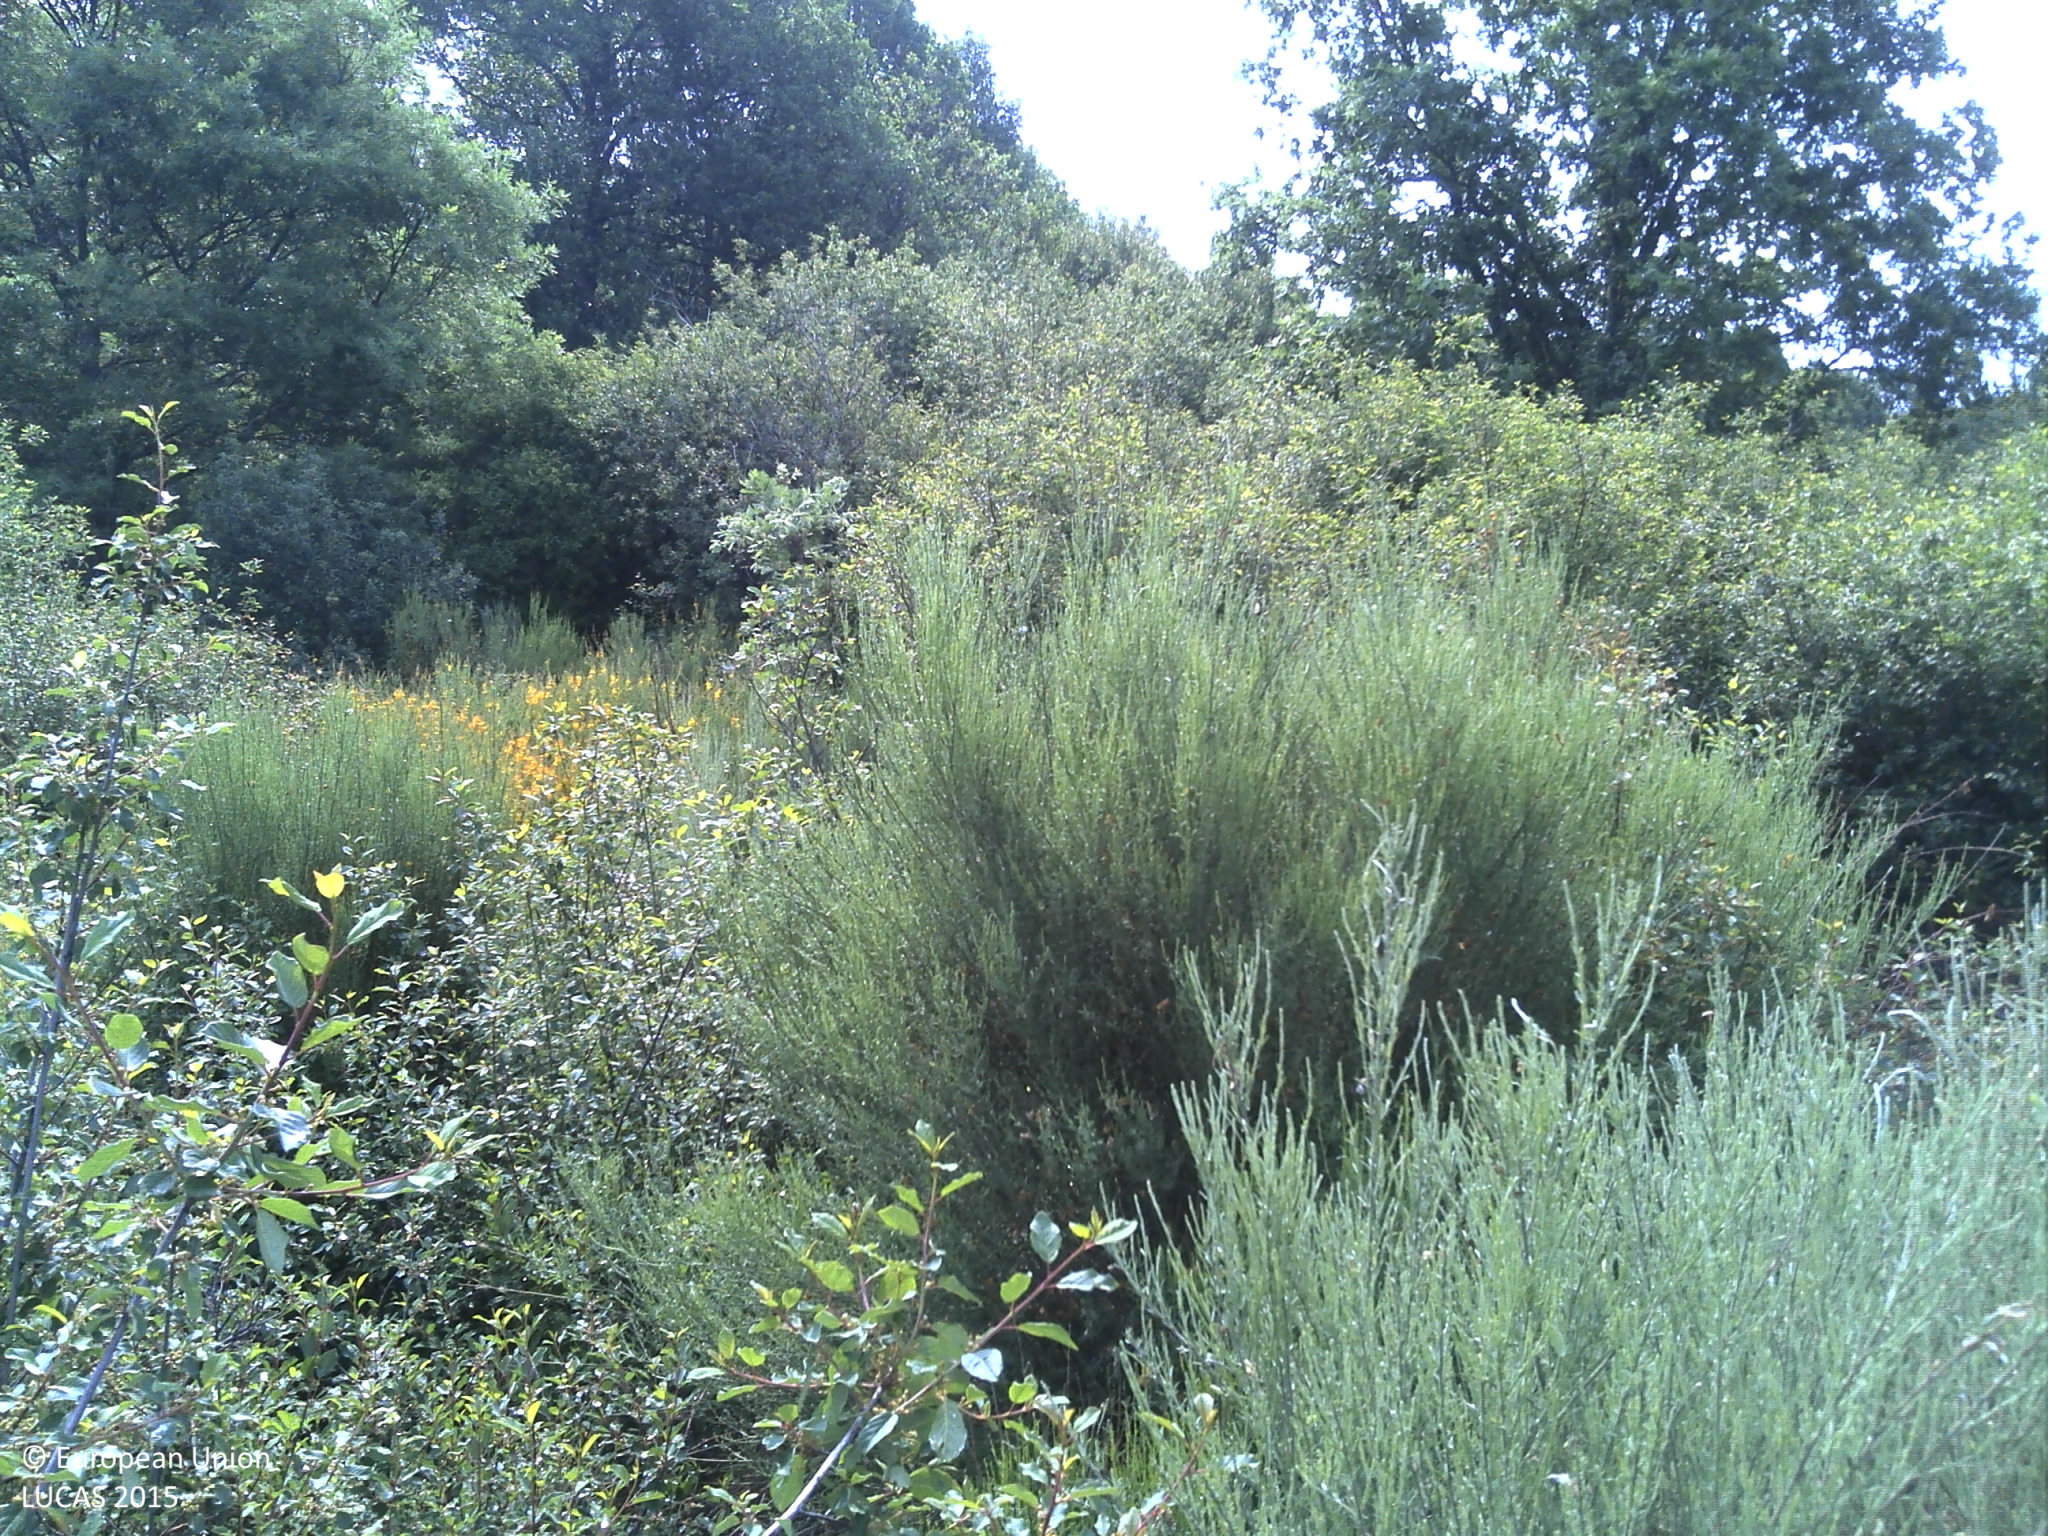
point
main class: Shrubland
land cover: Shrubland with sparse tree cover
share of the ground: > 75 %
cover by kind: shrubs 95 %, broadleaved forest trees 5 %
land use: Semi-natural and natural areas not in use
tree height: > 5 m
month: June
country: PT
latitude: 41.4409
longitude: -7.5417
